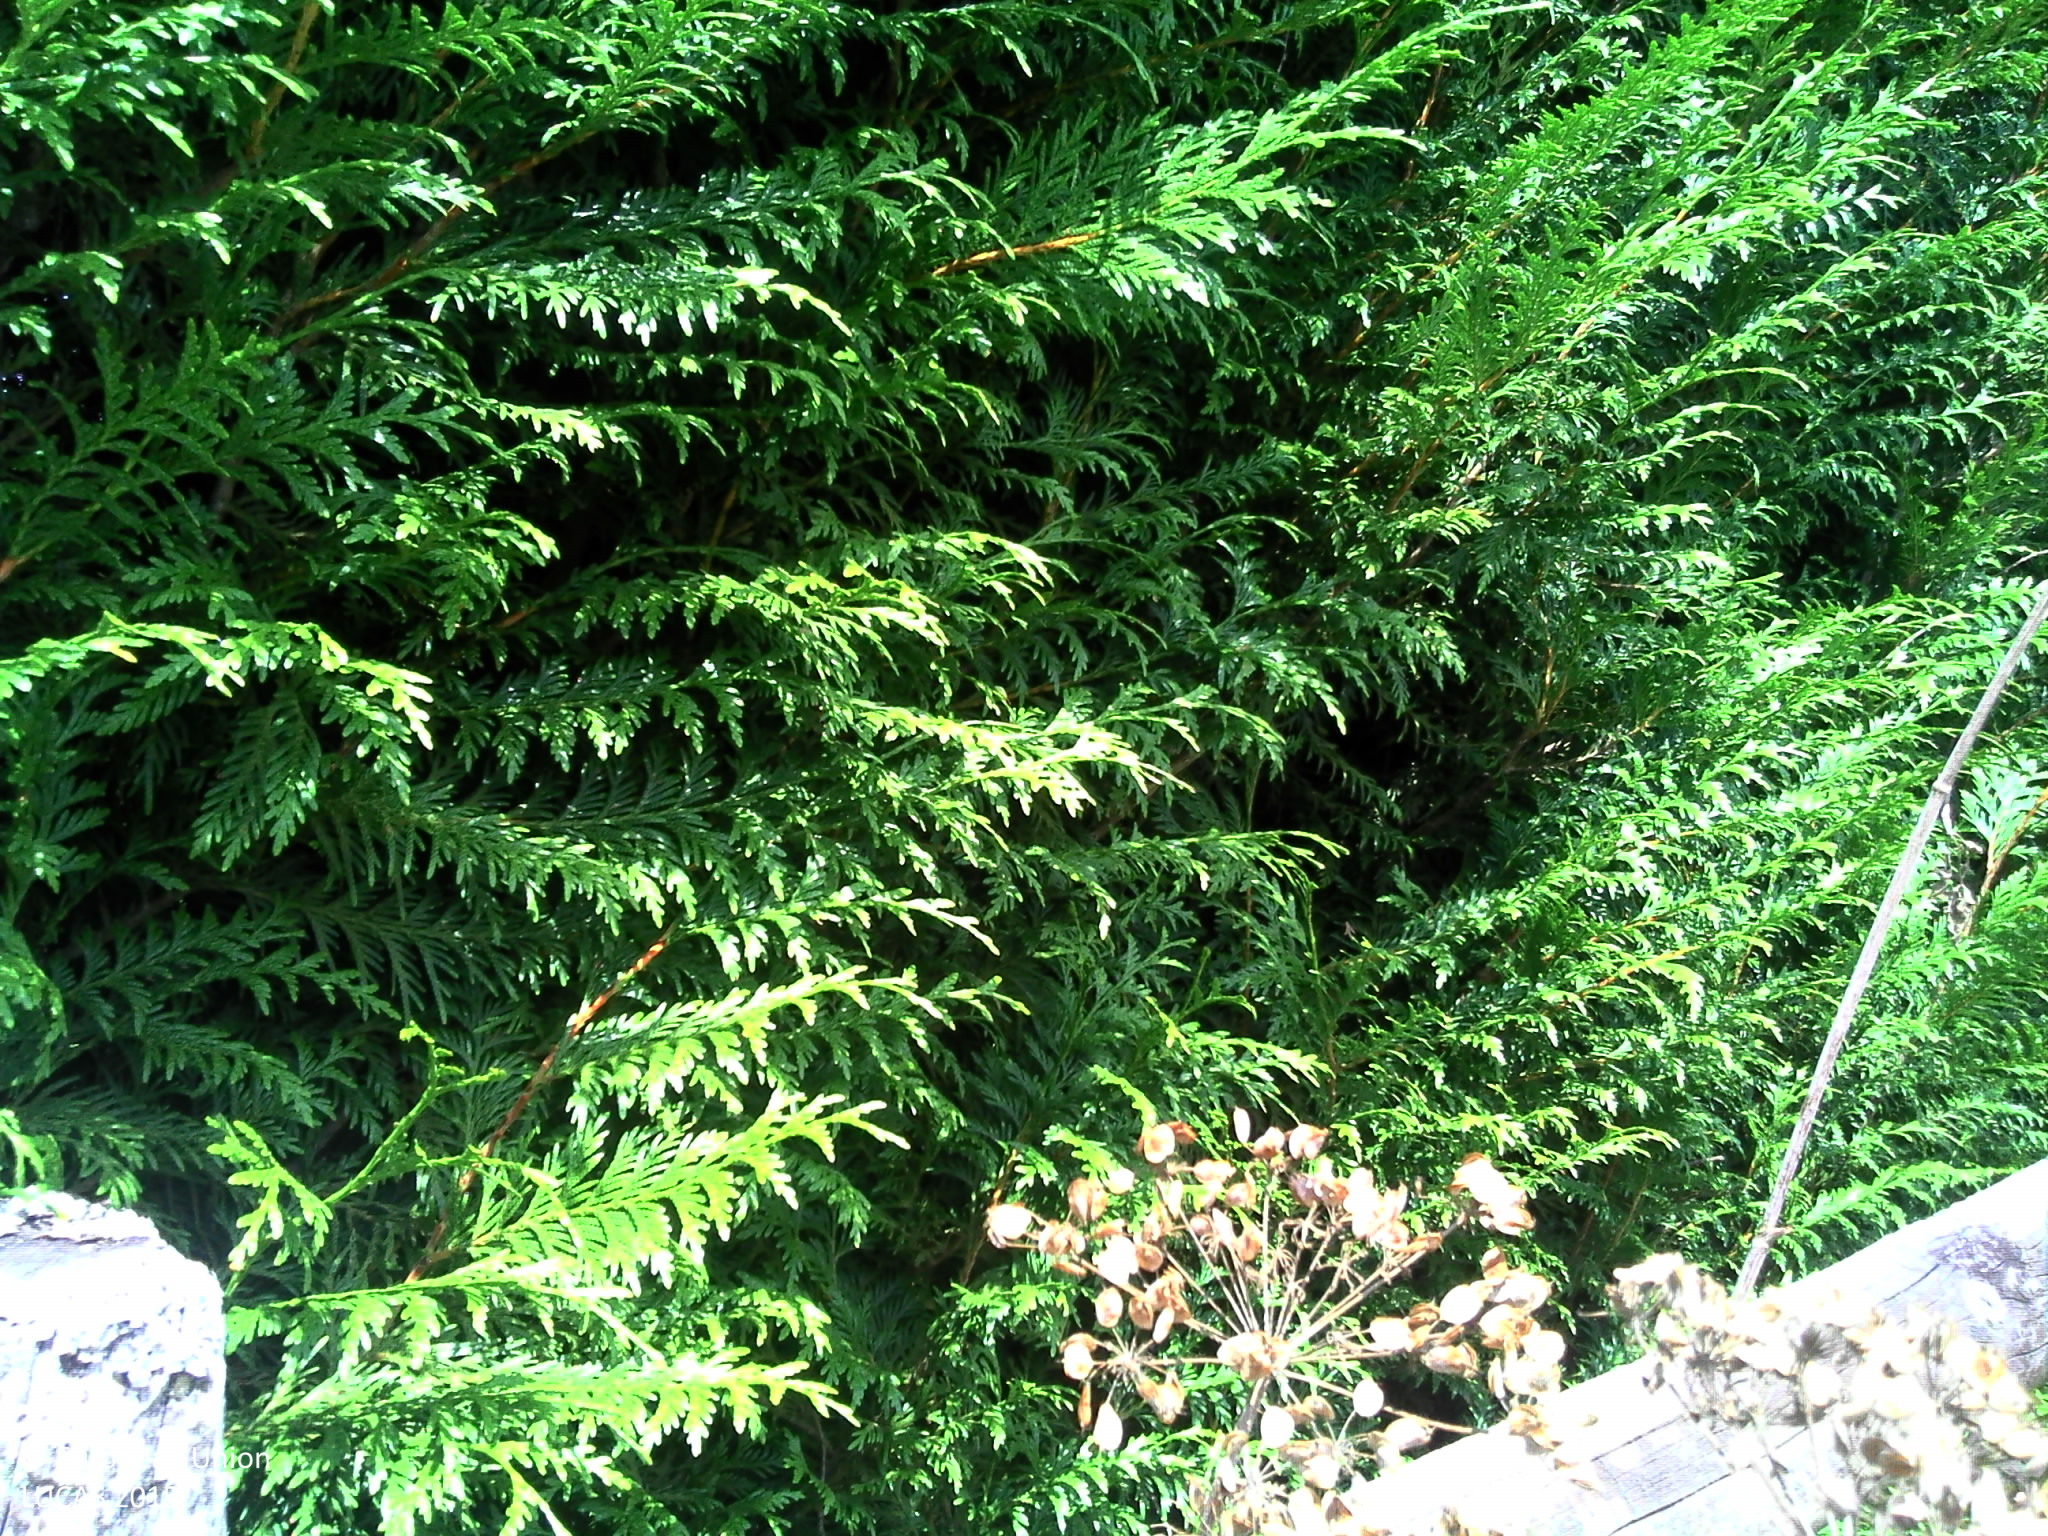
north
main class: Grassland
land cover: Grassland without tree/shrub cover
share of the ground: > 75 %
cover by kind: herbaceous plants 100 %
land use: Residential
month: July
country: FR
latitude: 48.6246
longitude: 0.4641
